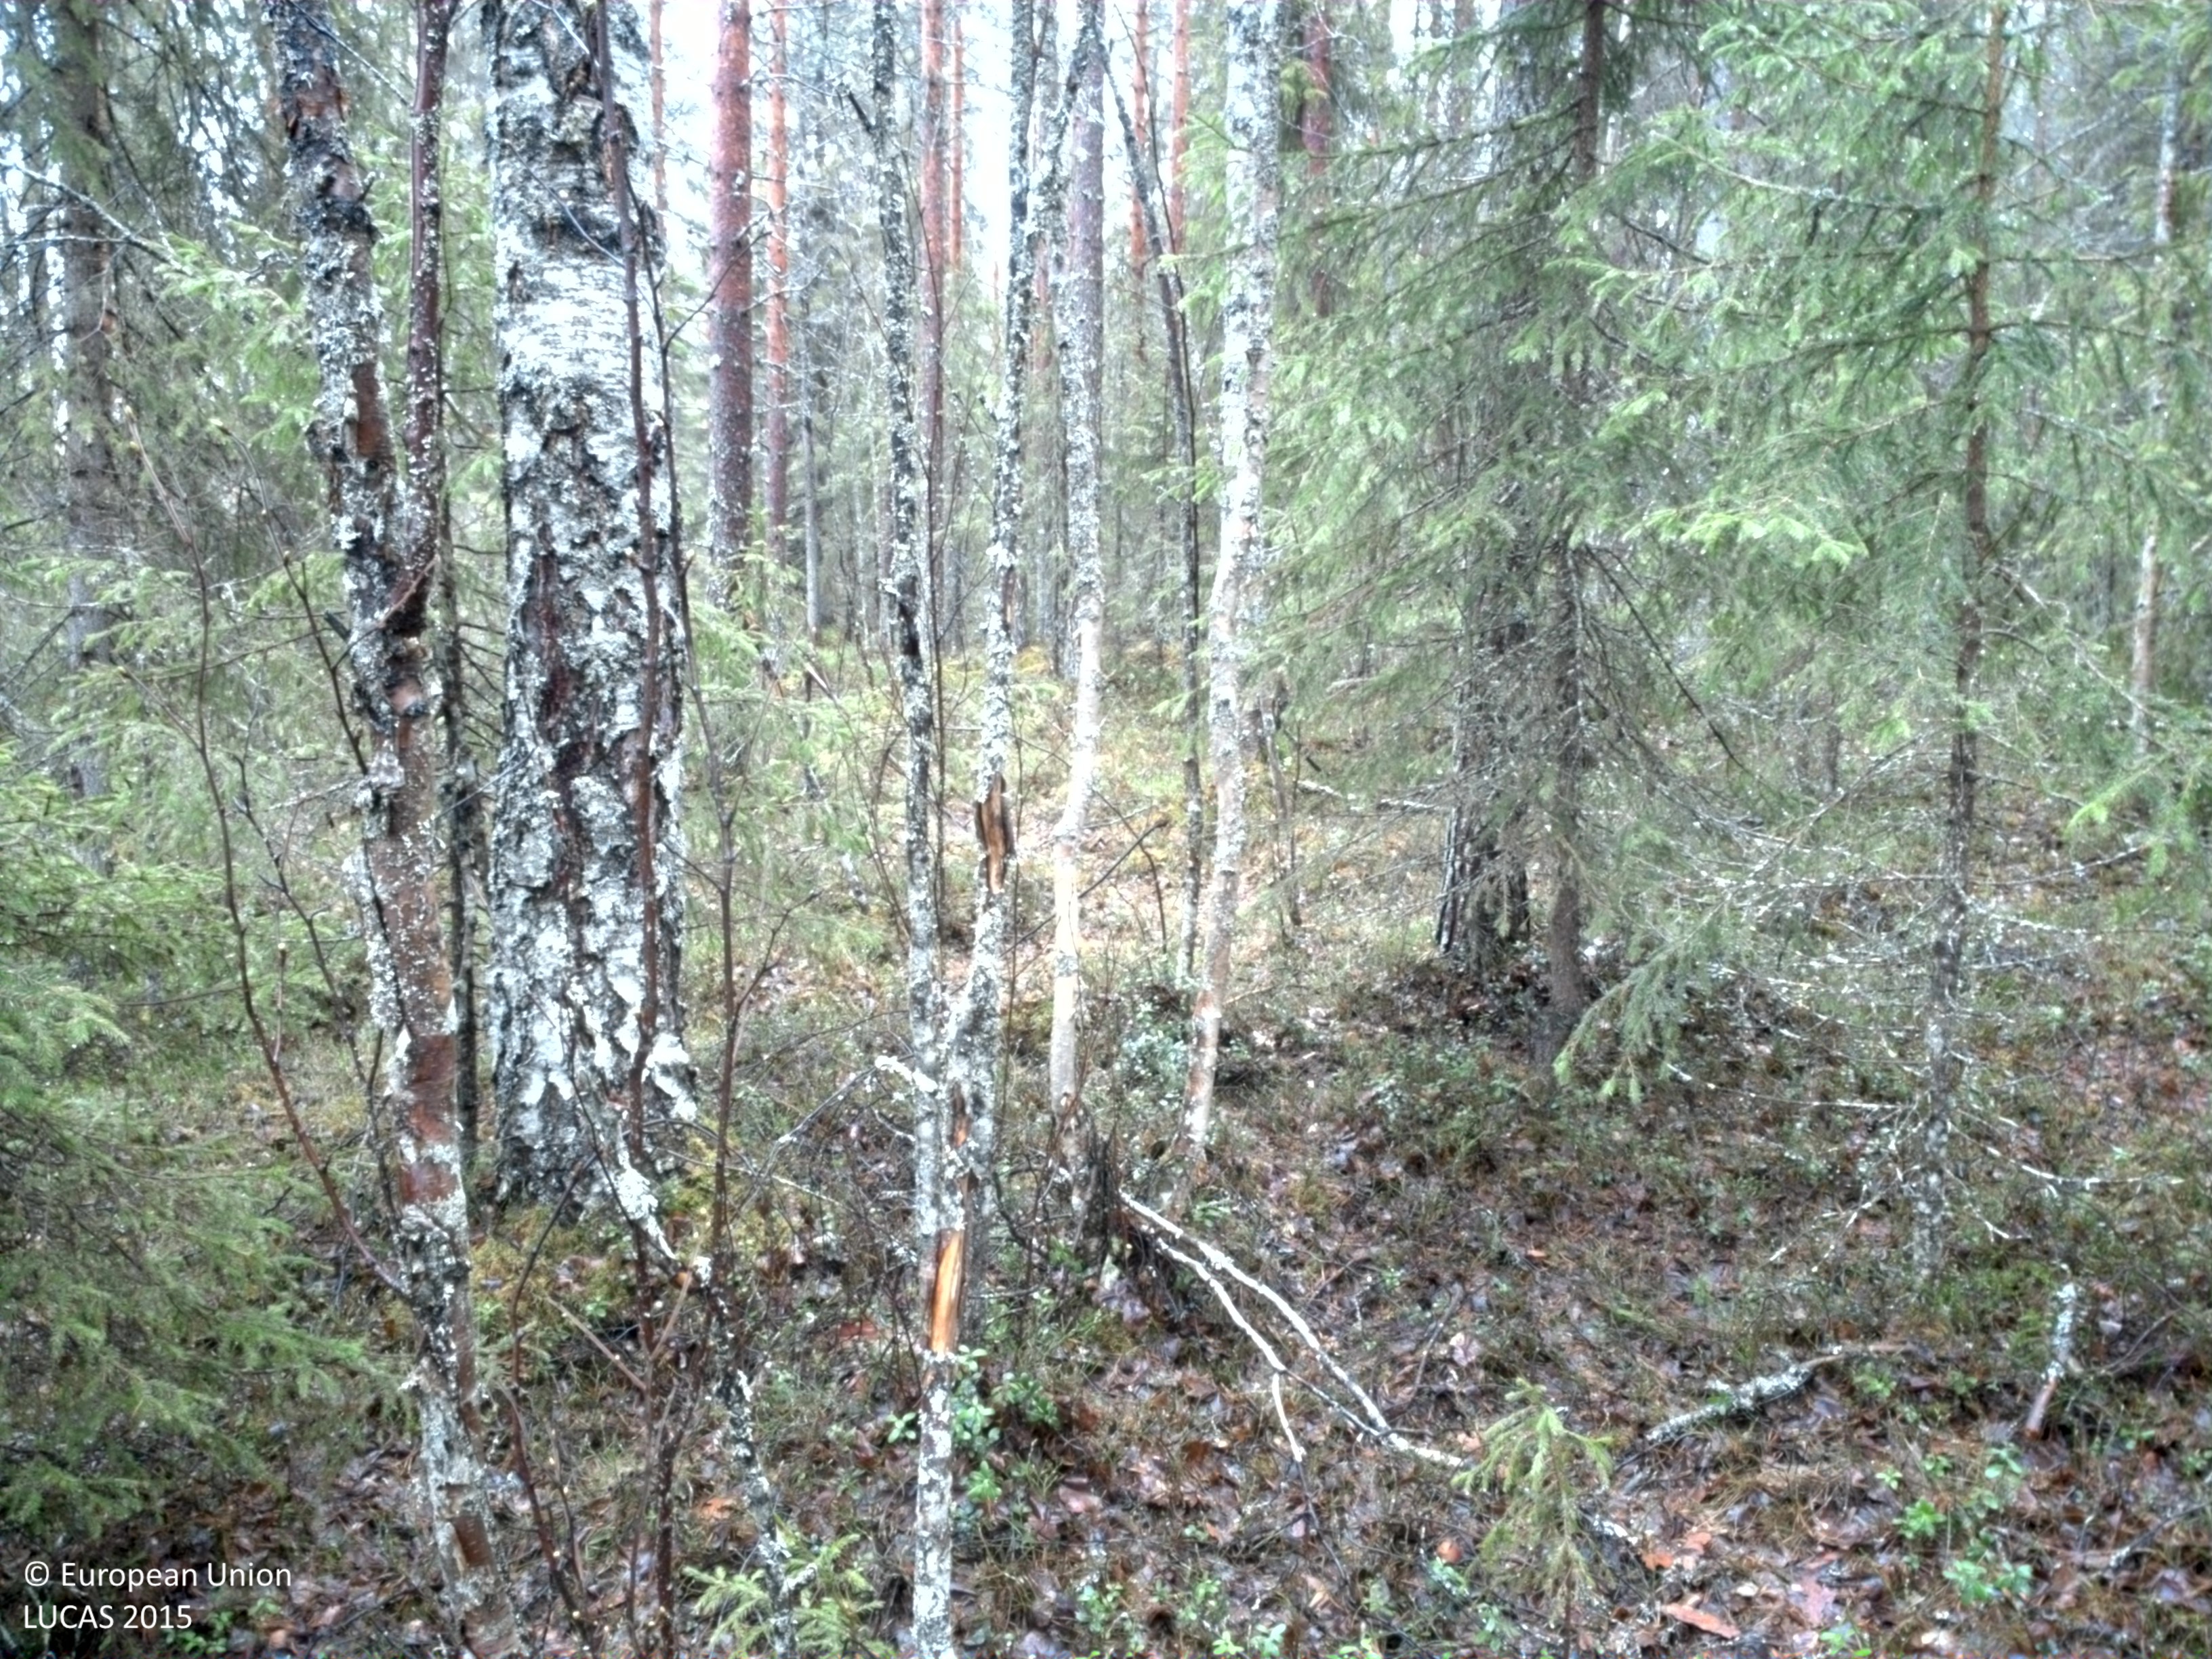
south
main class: Woodland
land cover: Pine dominated coniferous woodland
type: boreal forest
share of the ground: 50 - 75 %
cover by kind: coniferous forest trees 70 %, shrubs 15 %, lichens and mosses 10 %, broadleaved forest trees 5 %
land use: Forestry
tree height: > 5 m
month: May
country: SE
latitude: 66.5370
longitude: 23.3280
